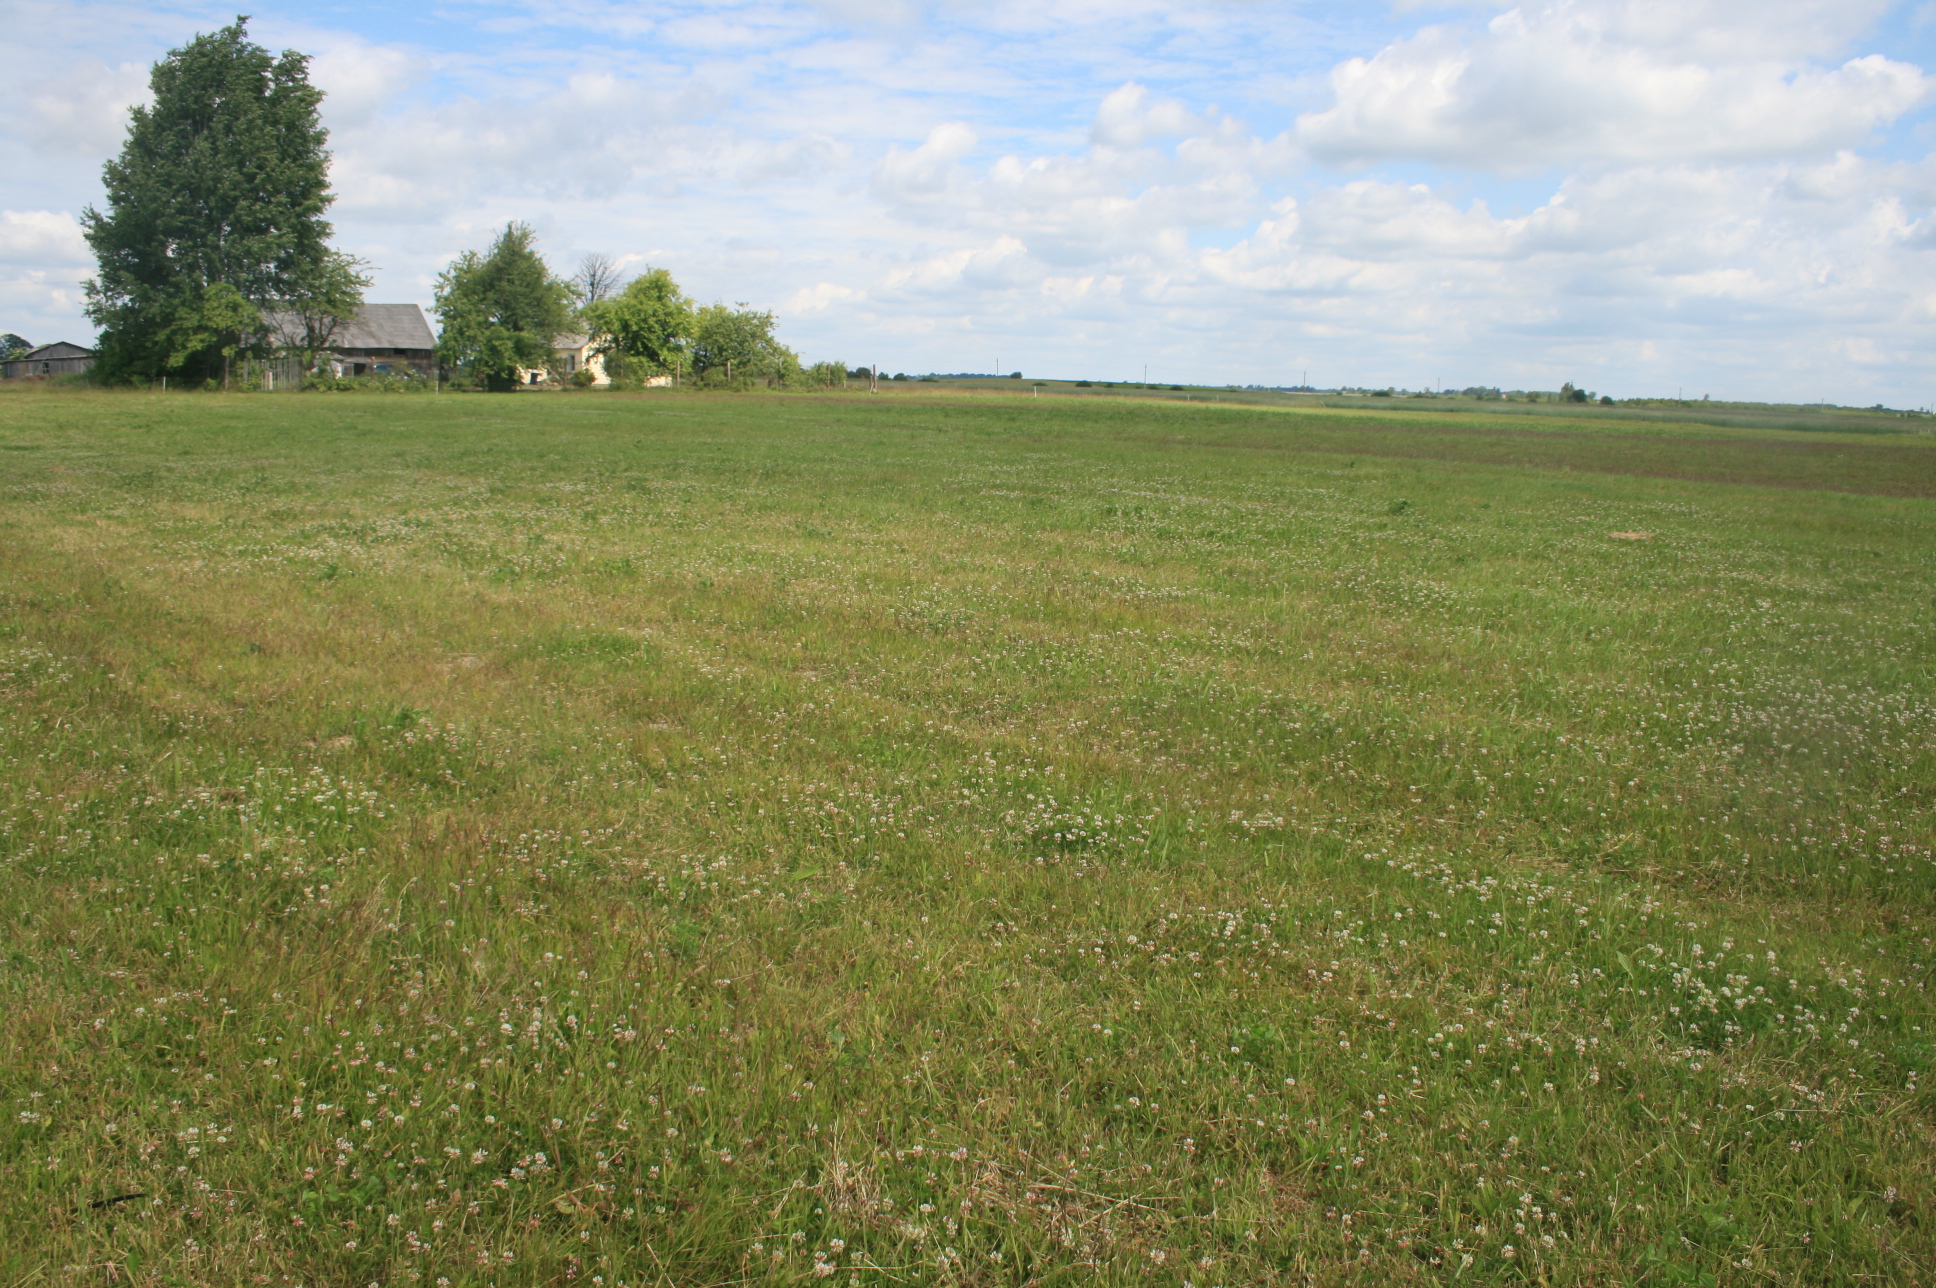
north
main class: Grassland
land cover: Grassland without tree/shrub cover
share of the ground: > 75 %
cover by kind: herbaceous plants 100 %
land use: Agriculture (excluding fallow land and kitchen gardens)
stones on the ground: < 10 %
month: June
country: LT
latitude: 55.3205
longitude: 21.7270
